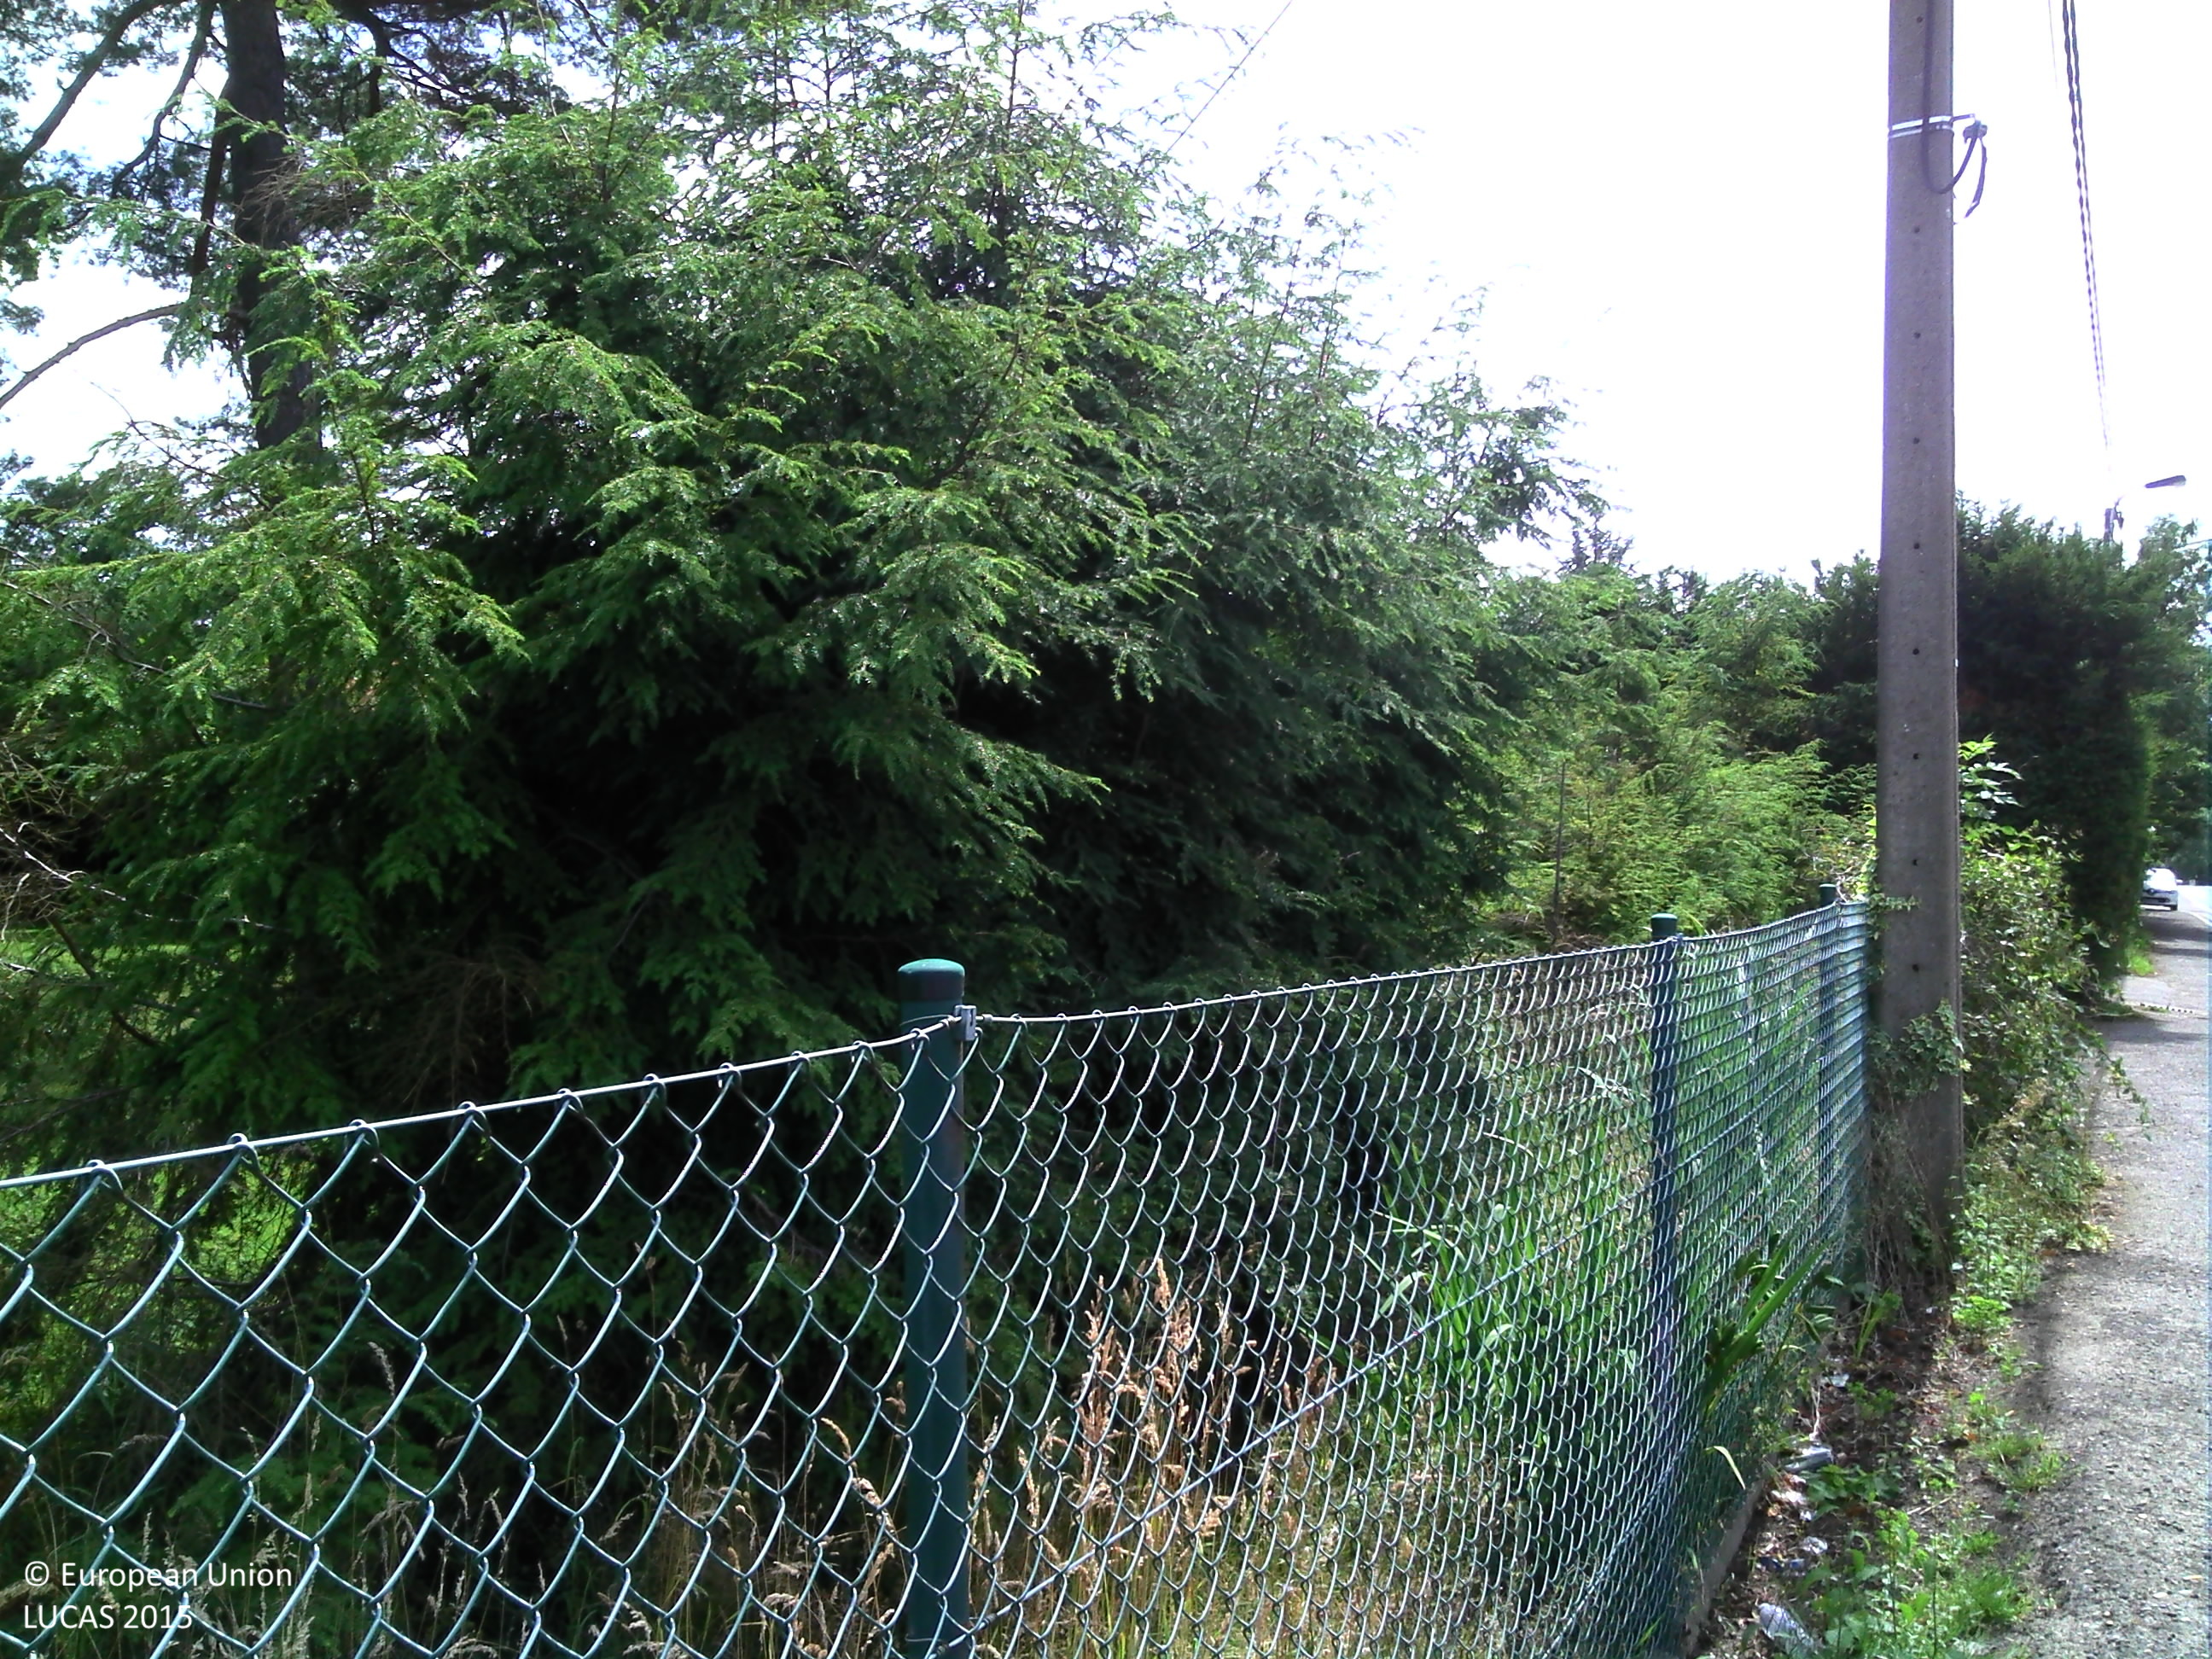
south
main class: Grassland
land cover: Grassland with sparse tree/shrub cover
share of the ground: > 75 %
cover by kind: herbaceous plants 95 %, coniferous forest trees 5 %
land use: Residential
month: July
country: BE
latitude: 50.5593
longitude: 5.8628
